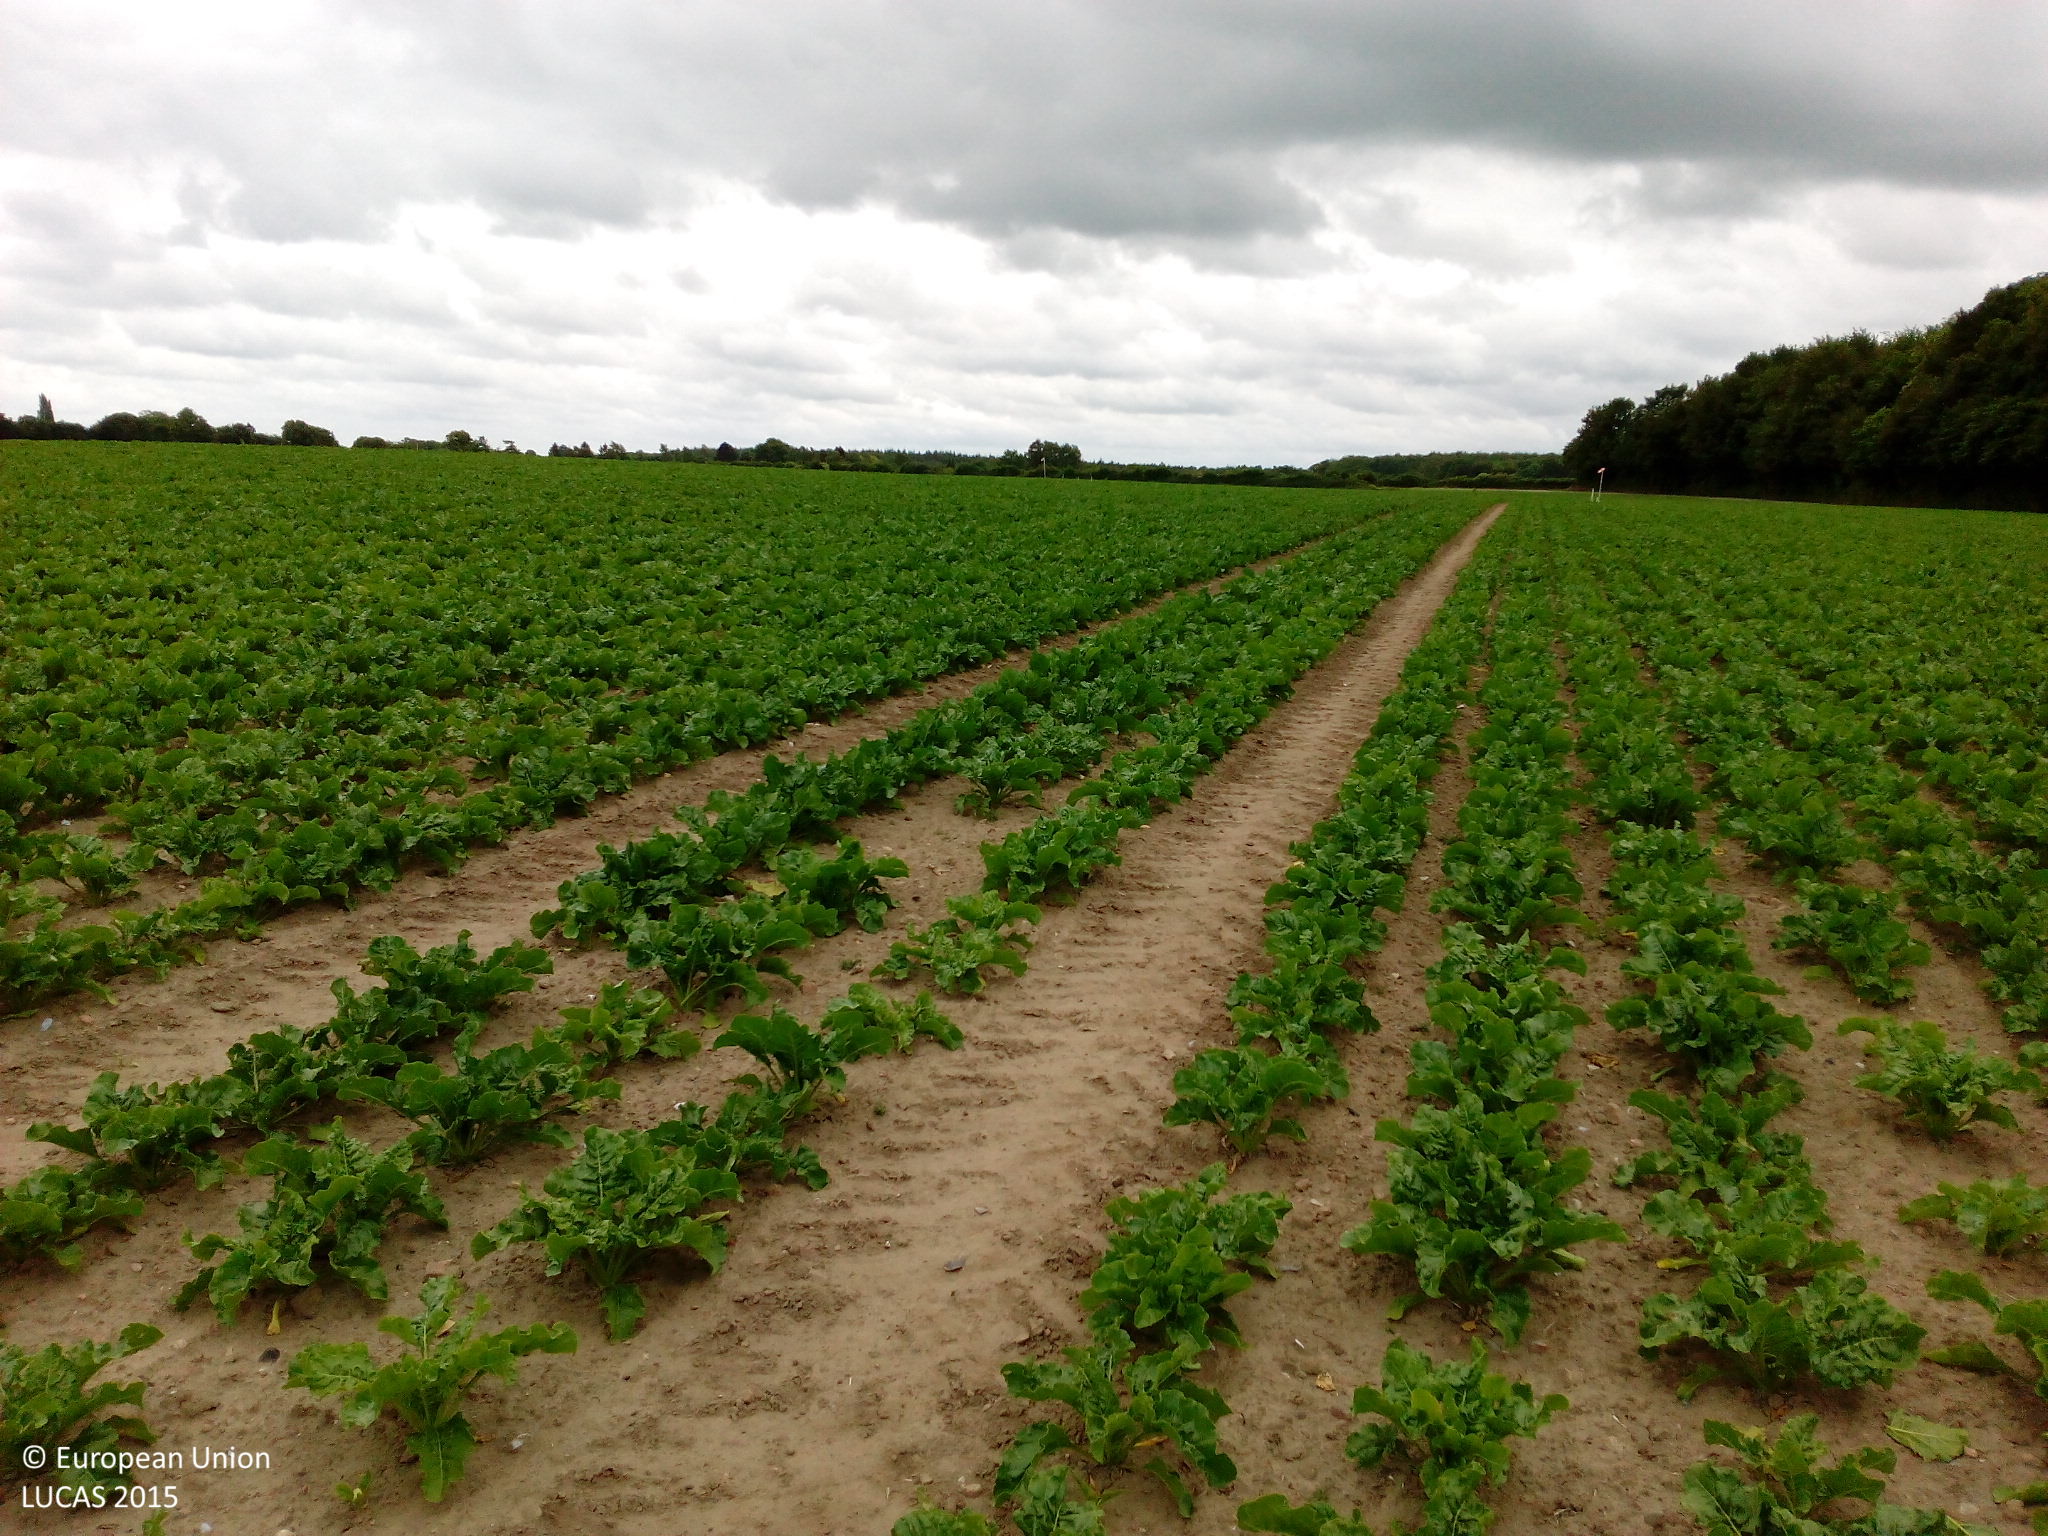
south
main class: Cropland
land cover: Sugar beet
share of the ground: 50 - 75 %
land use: Agriculture (excluding fallow land and kitchen gardens)
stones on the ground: 10 - 25 %
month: June
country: DK
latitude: 54.8294
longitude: 11.6023
